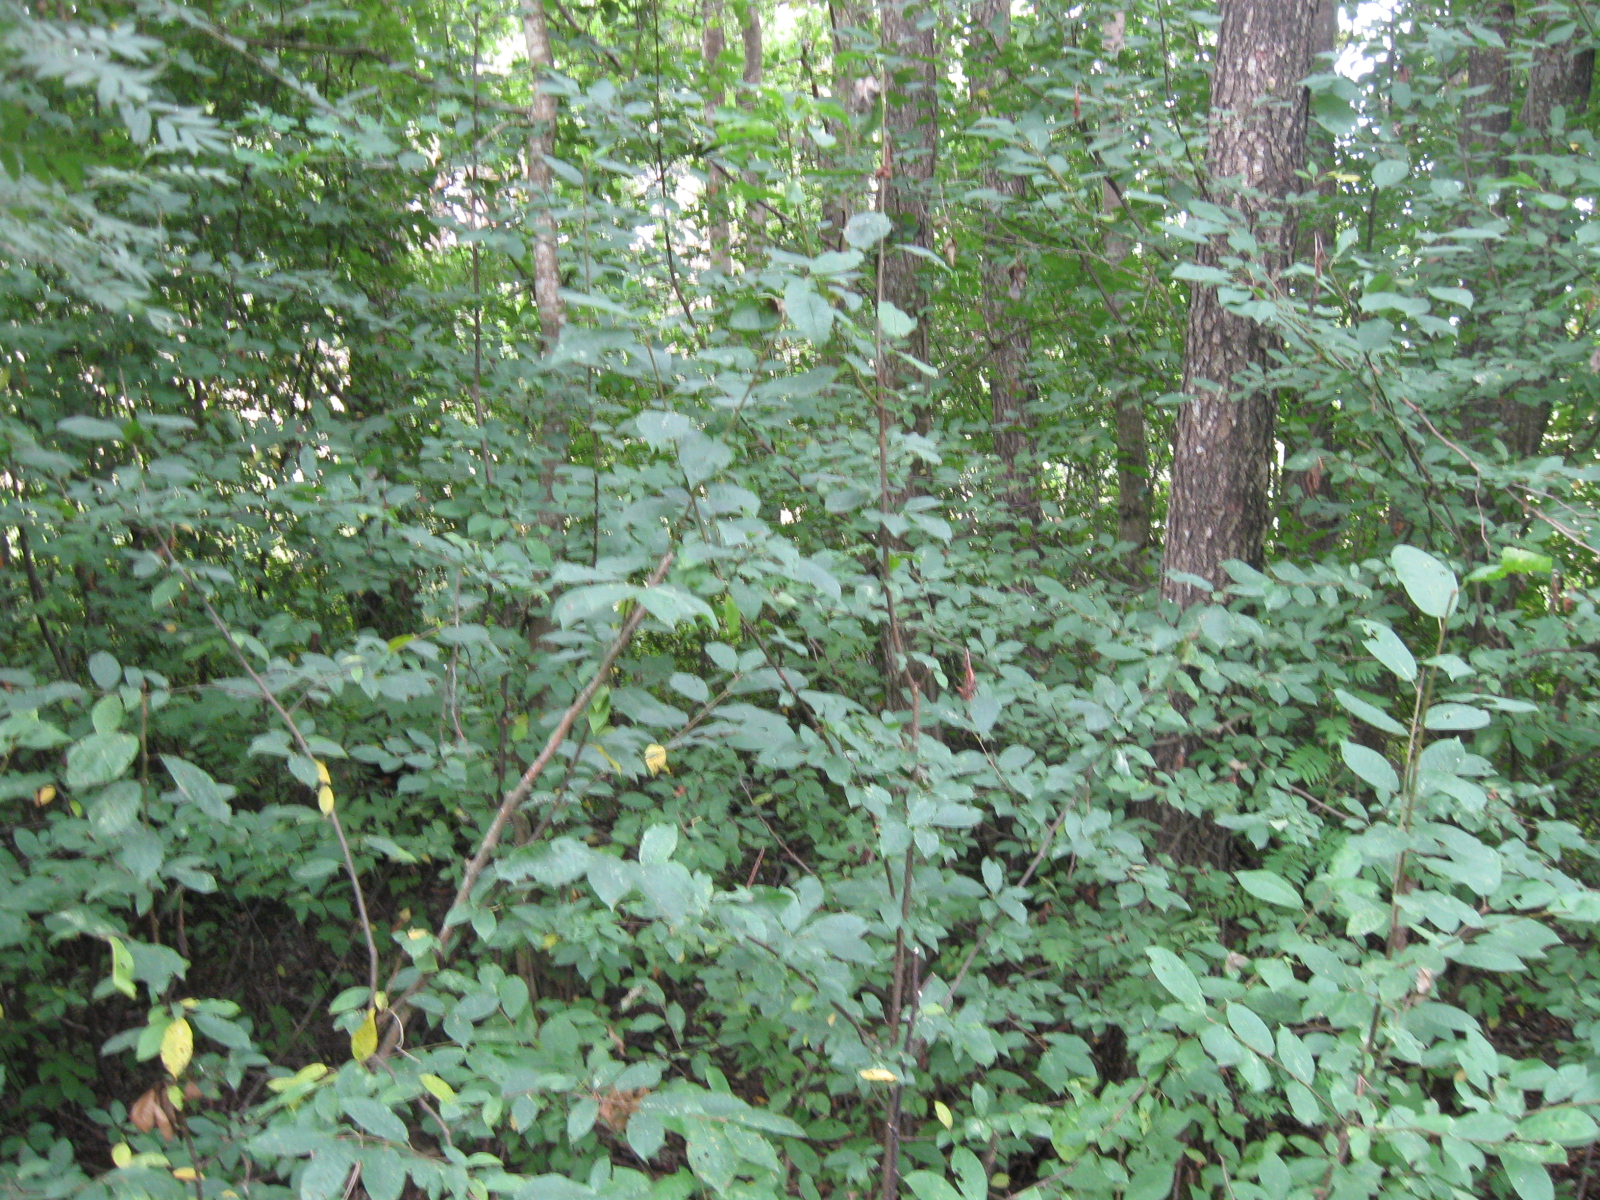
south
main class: Woodland
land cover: Broadleaved woodland
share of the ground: > 75 %
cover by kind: broadleaved forest trees 85 %, herbaceous plants 10 %, shrubs 5 %
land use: Forestry
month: July
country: LT
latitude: 54.4198
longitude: 24.3868
